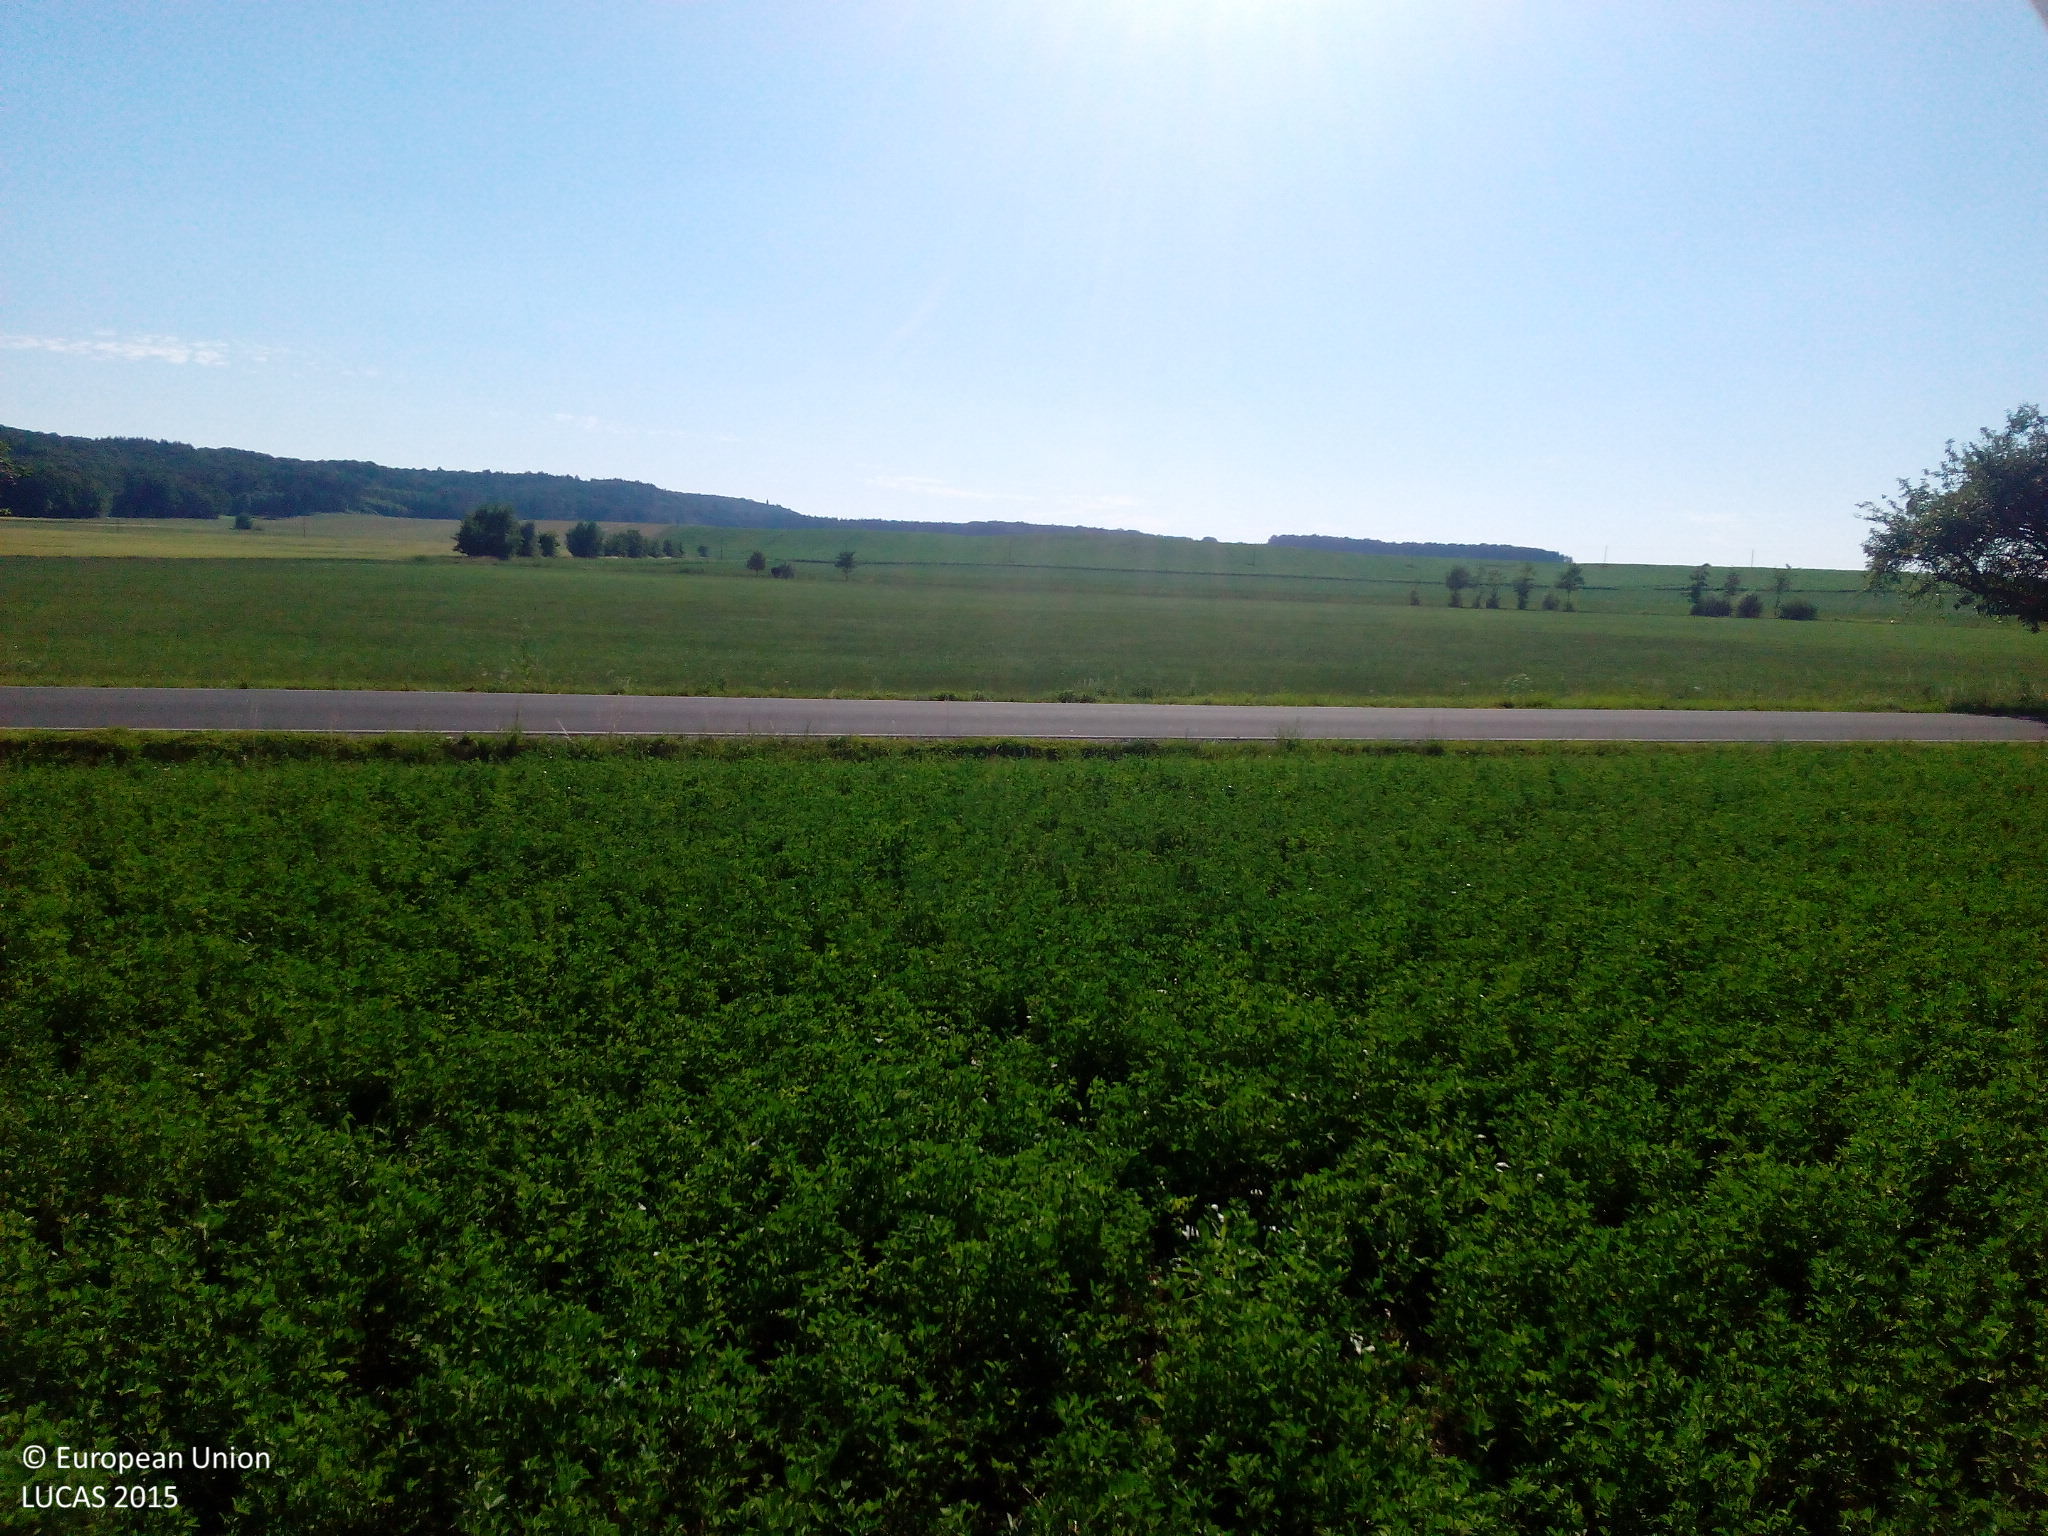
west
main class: Cropland
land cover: Lucerne
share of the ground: > 75 %
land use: Agriculture (excluding fallow land and kitchen gardens)
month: July
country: DE
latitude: 50.2904
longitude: 10.6314
